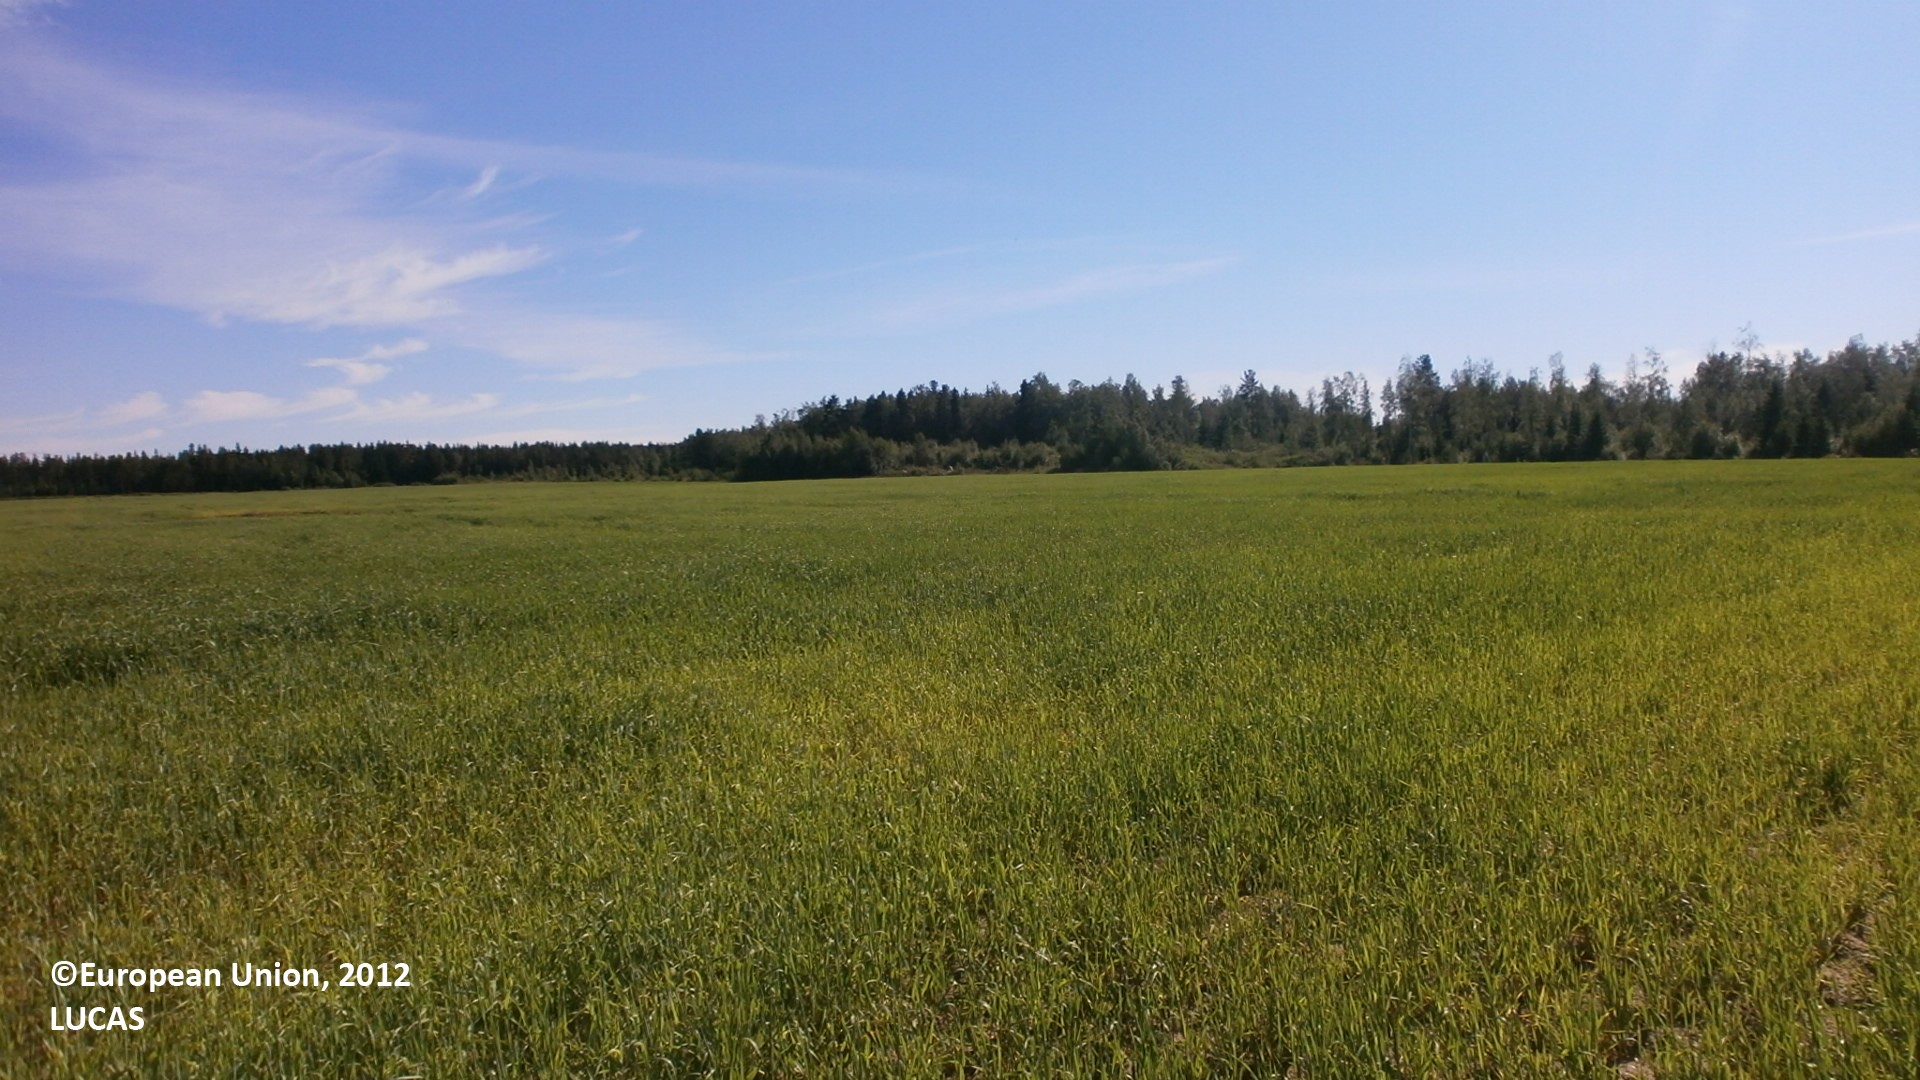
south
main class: Cropland
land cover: Barley
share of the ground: > 75 %
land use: Agriculture (excluding fallow land and kitchen gardens)
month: July
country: FI
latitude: 64.2954
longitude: 23.9267
